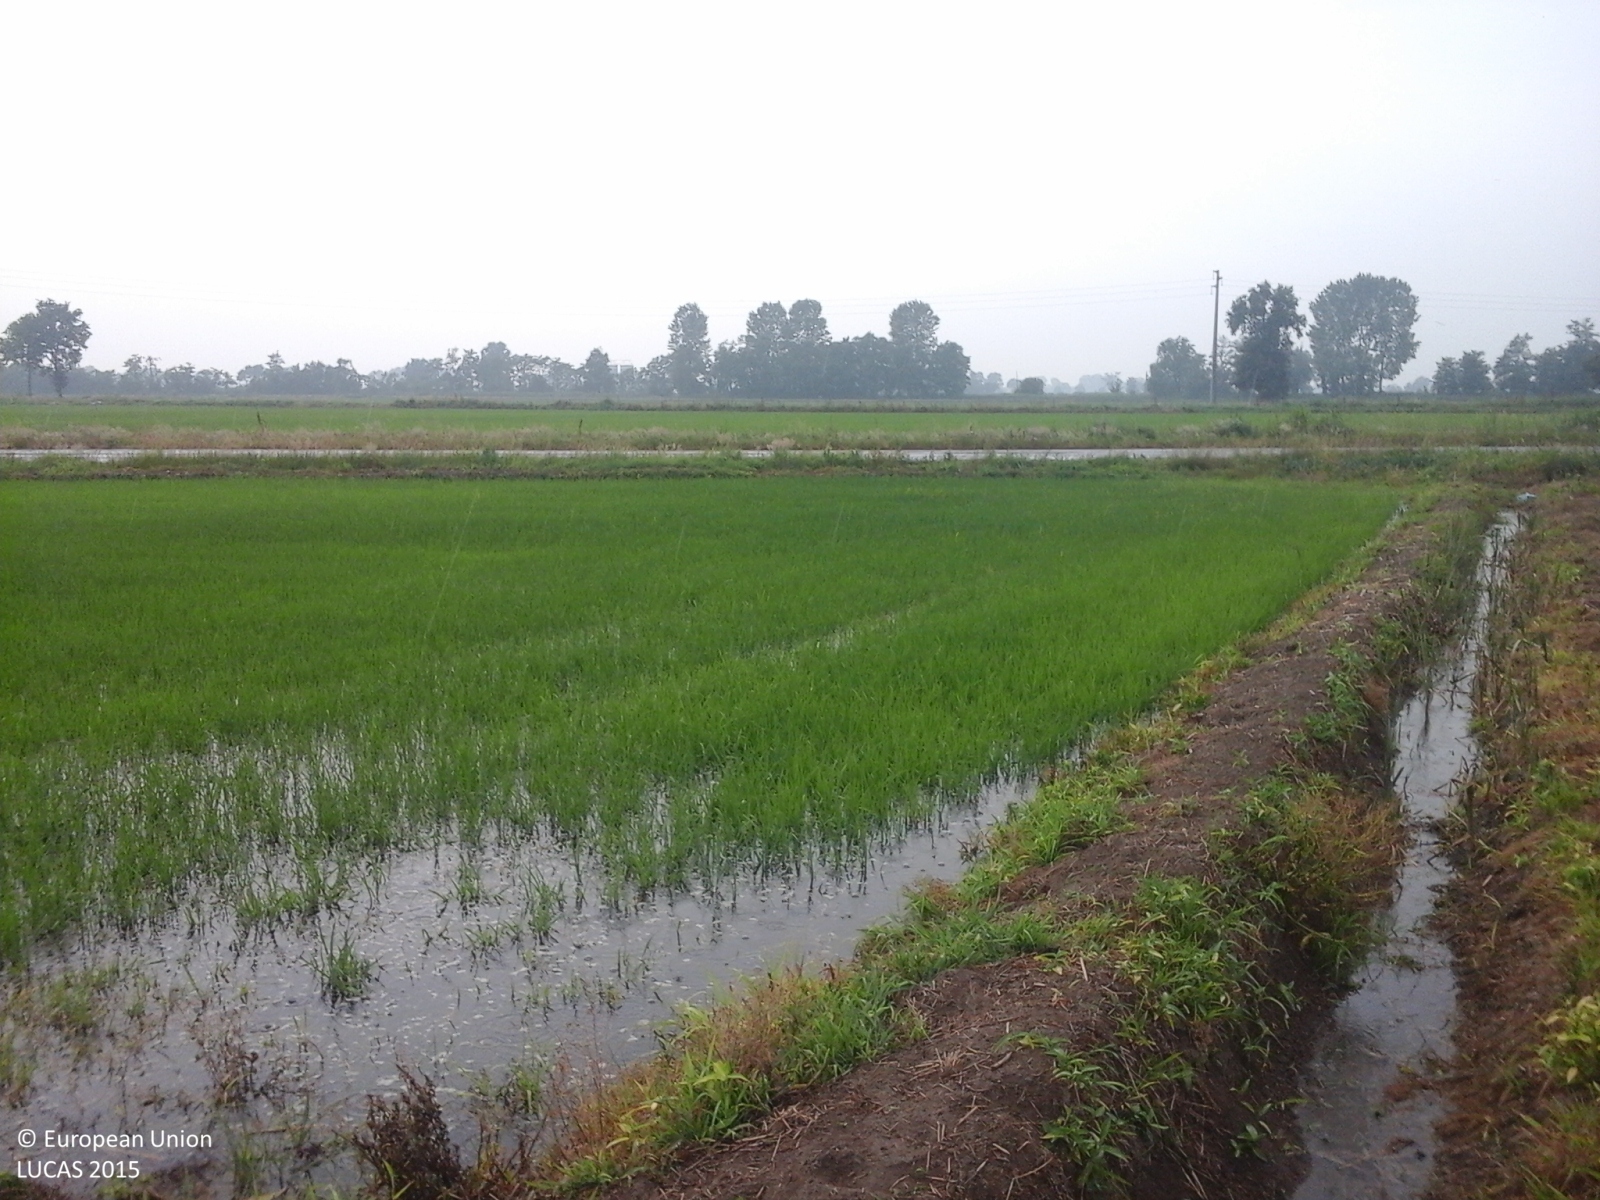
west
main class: Cropland
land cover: Rice
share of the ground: > 75 %
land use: Agriculture (excluding fallow land and kitchen gardens)
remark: Temporary flooded
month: June
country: IT
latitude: 45.1550
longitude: 8.7938
